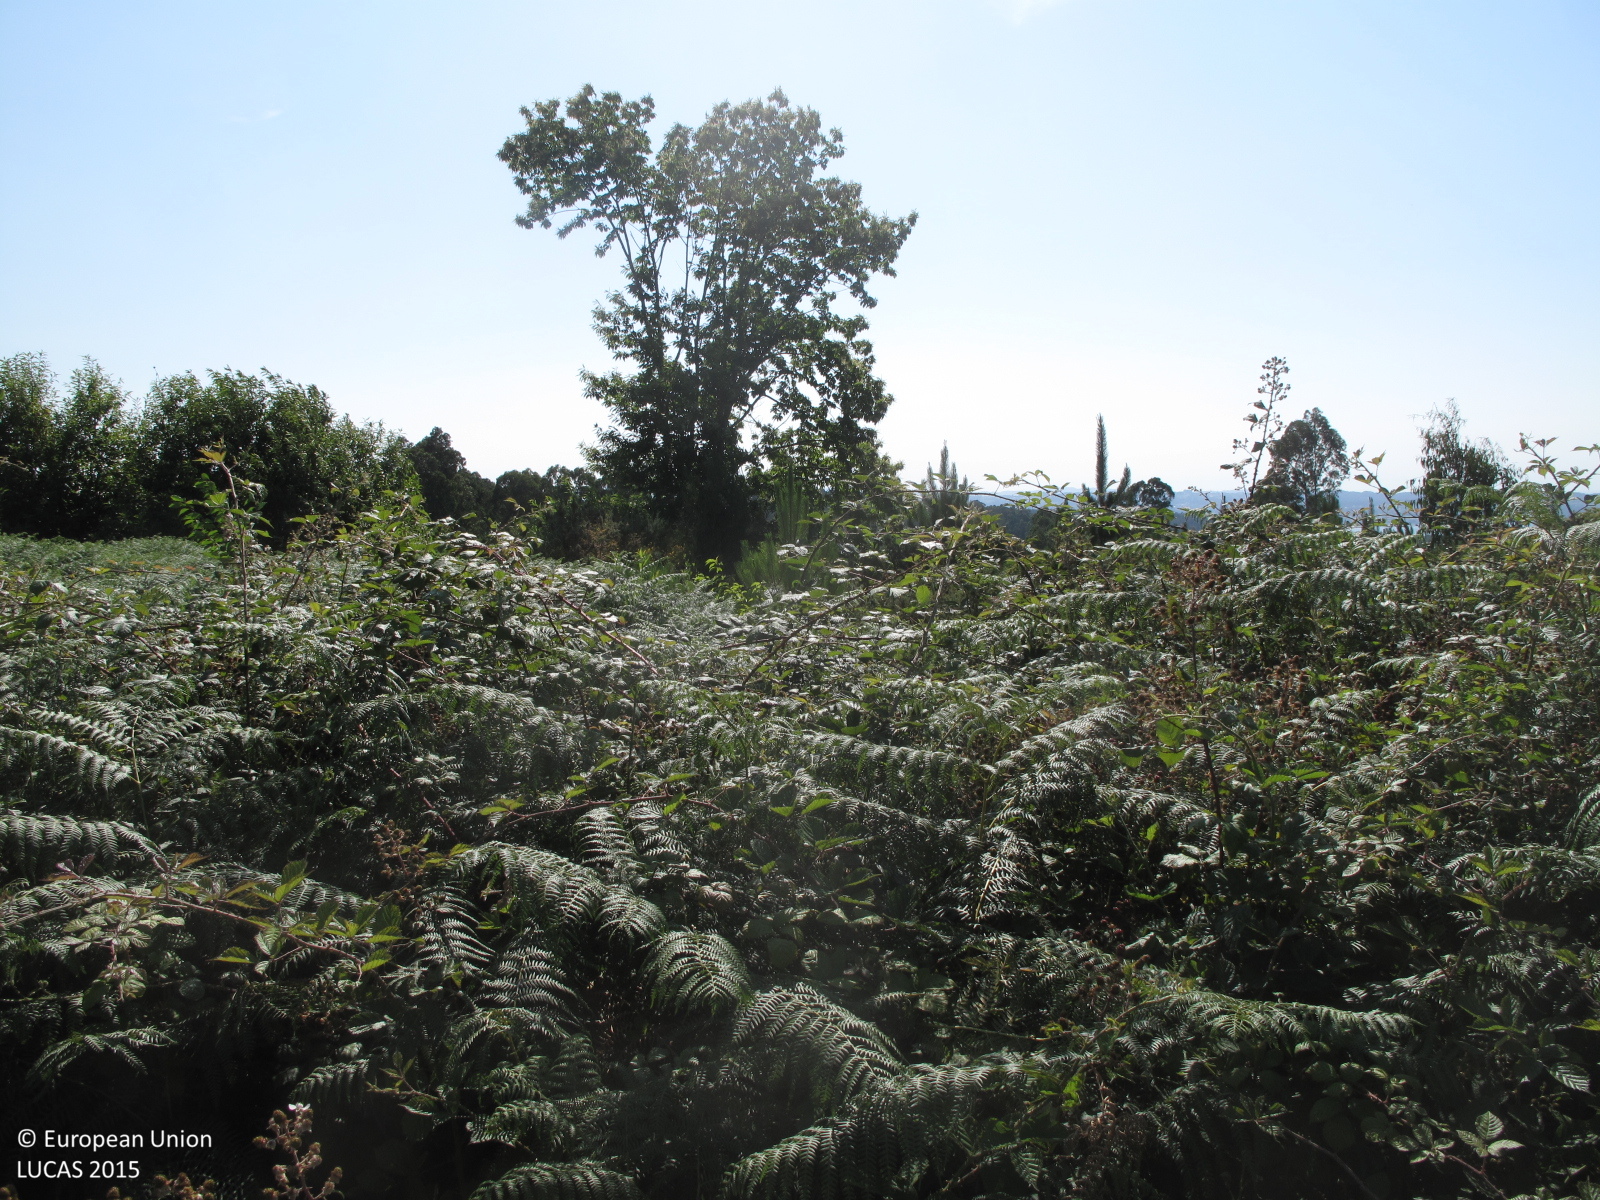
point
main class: Shrubland
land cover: Shrubland with sparse tree cover
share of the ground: 10 - 25 %
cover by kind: herbaceous plants 75 %, shrubs 20 %, broadleaved forest trees 5 %
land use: Abandoned areas
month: July
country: ES
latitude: 43.3431
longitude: -8.1455
